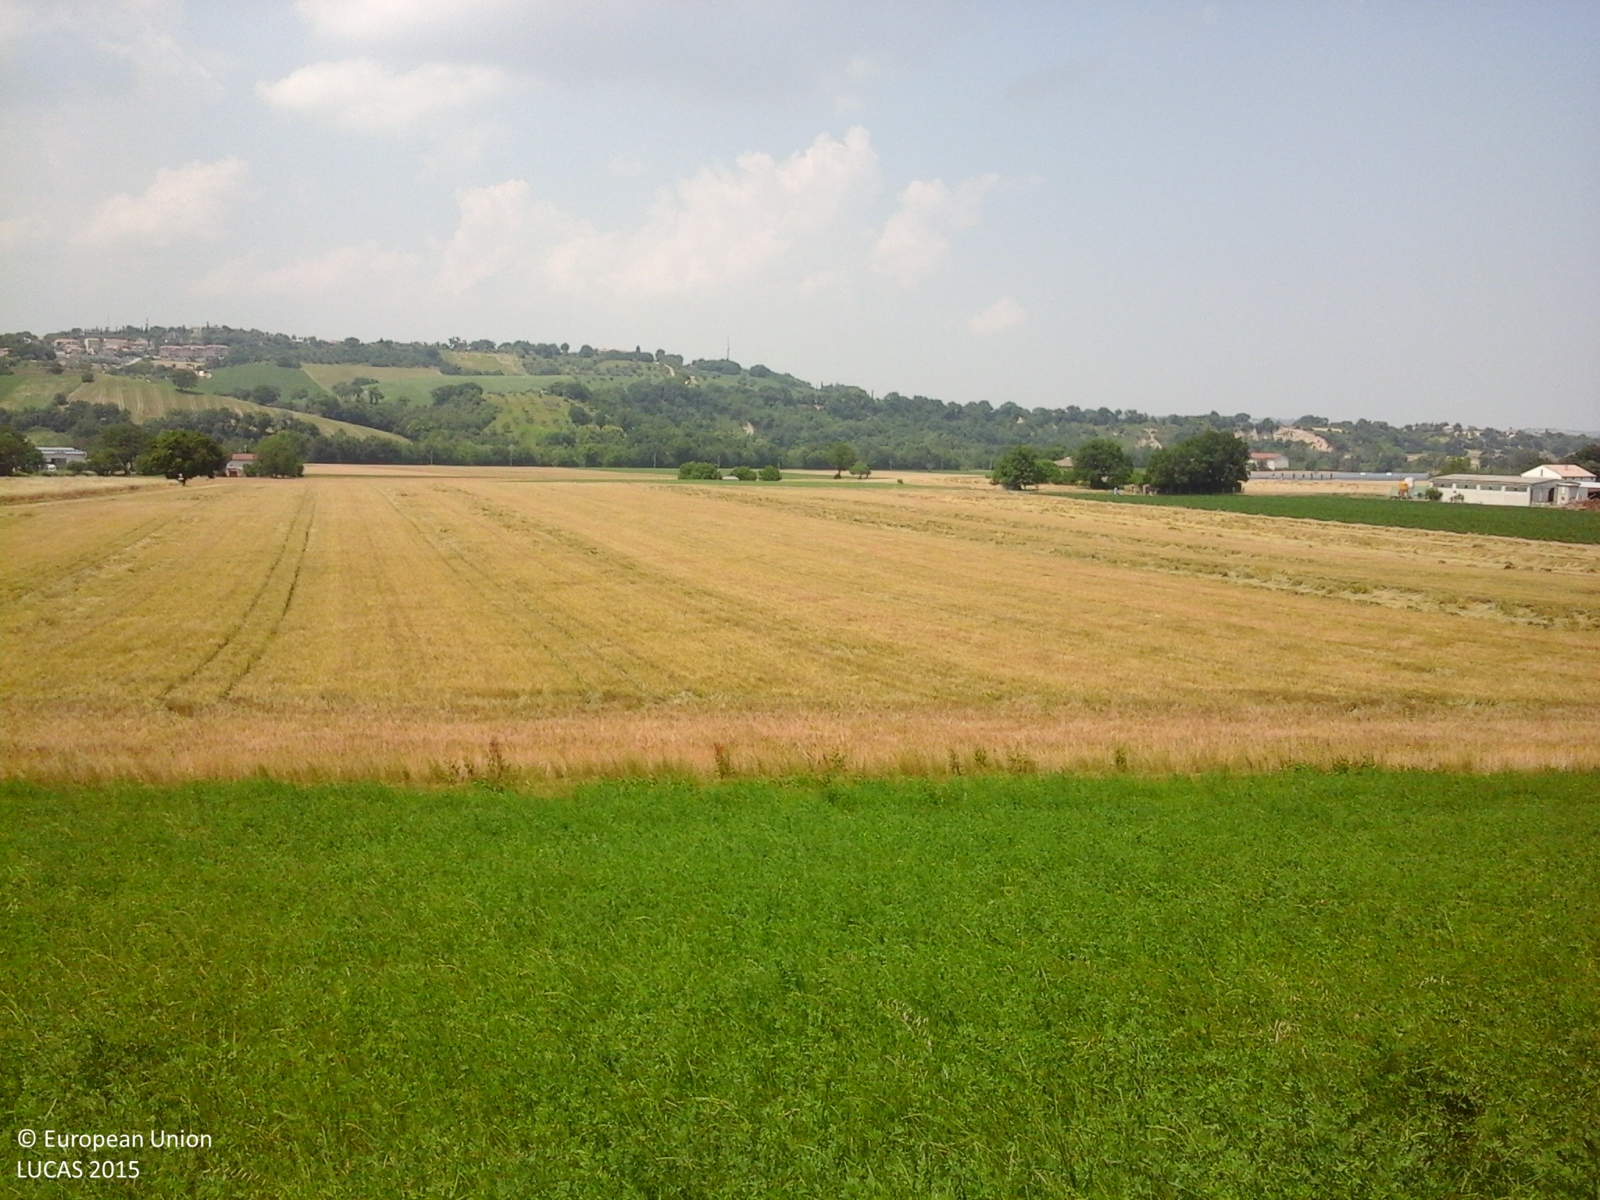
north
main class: Cropland
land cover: Lucerne
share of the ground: > 75 %
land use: Agriculture (excluding fallow land and kitchen gardens)
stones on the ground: > 50 %
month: June
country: IT
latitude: 43.2277
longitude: 13.4507
